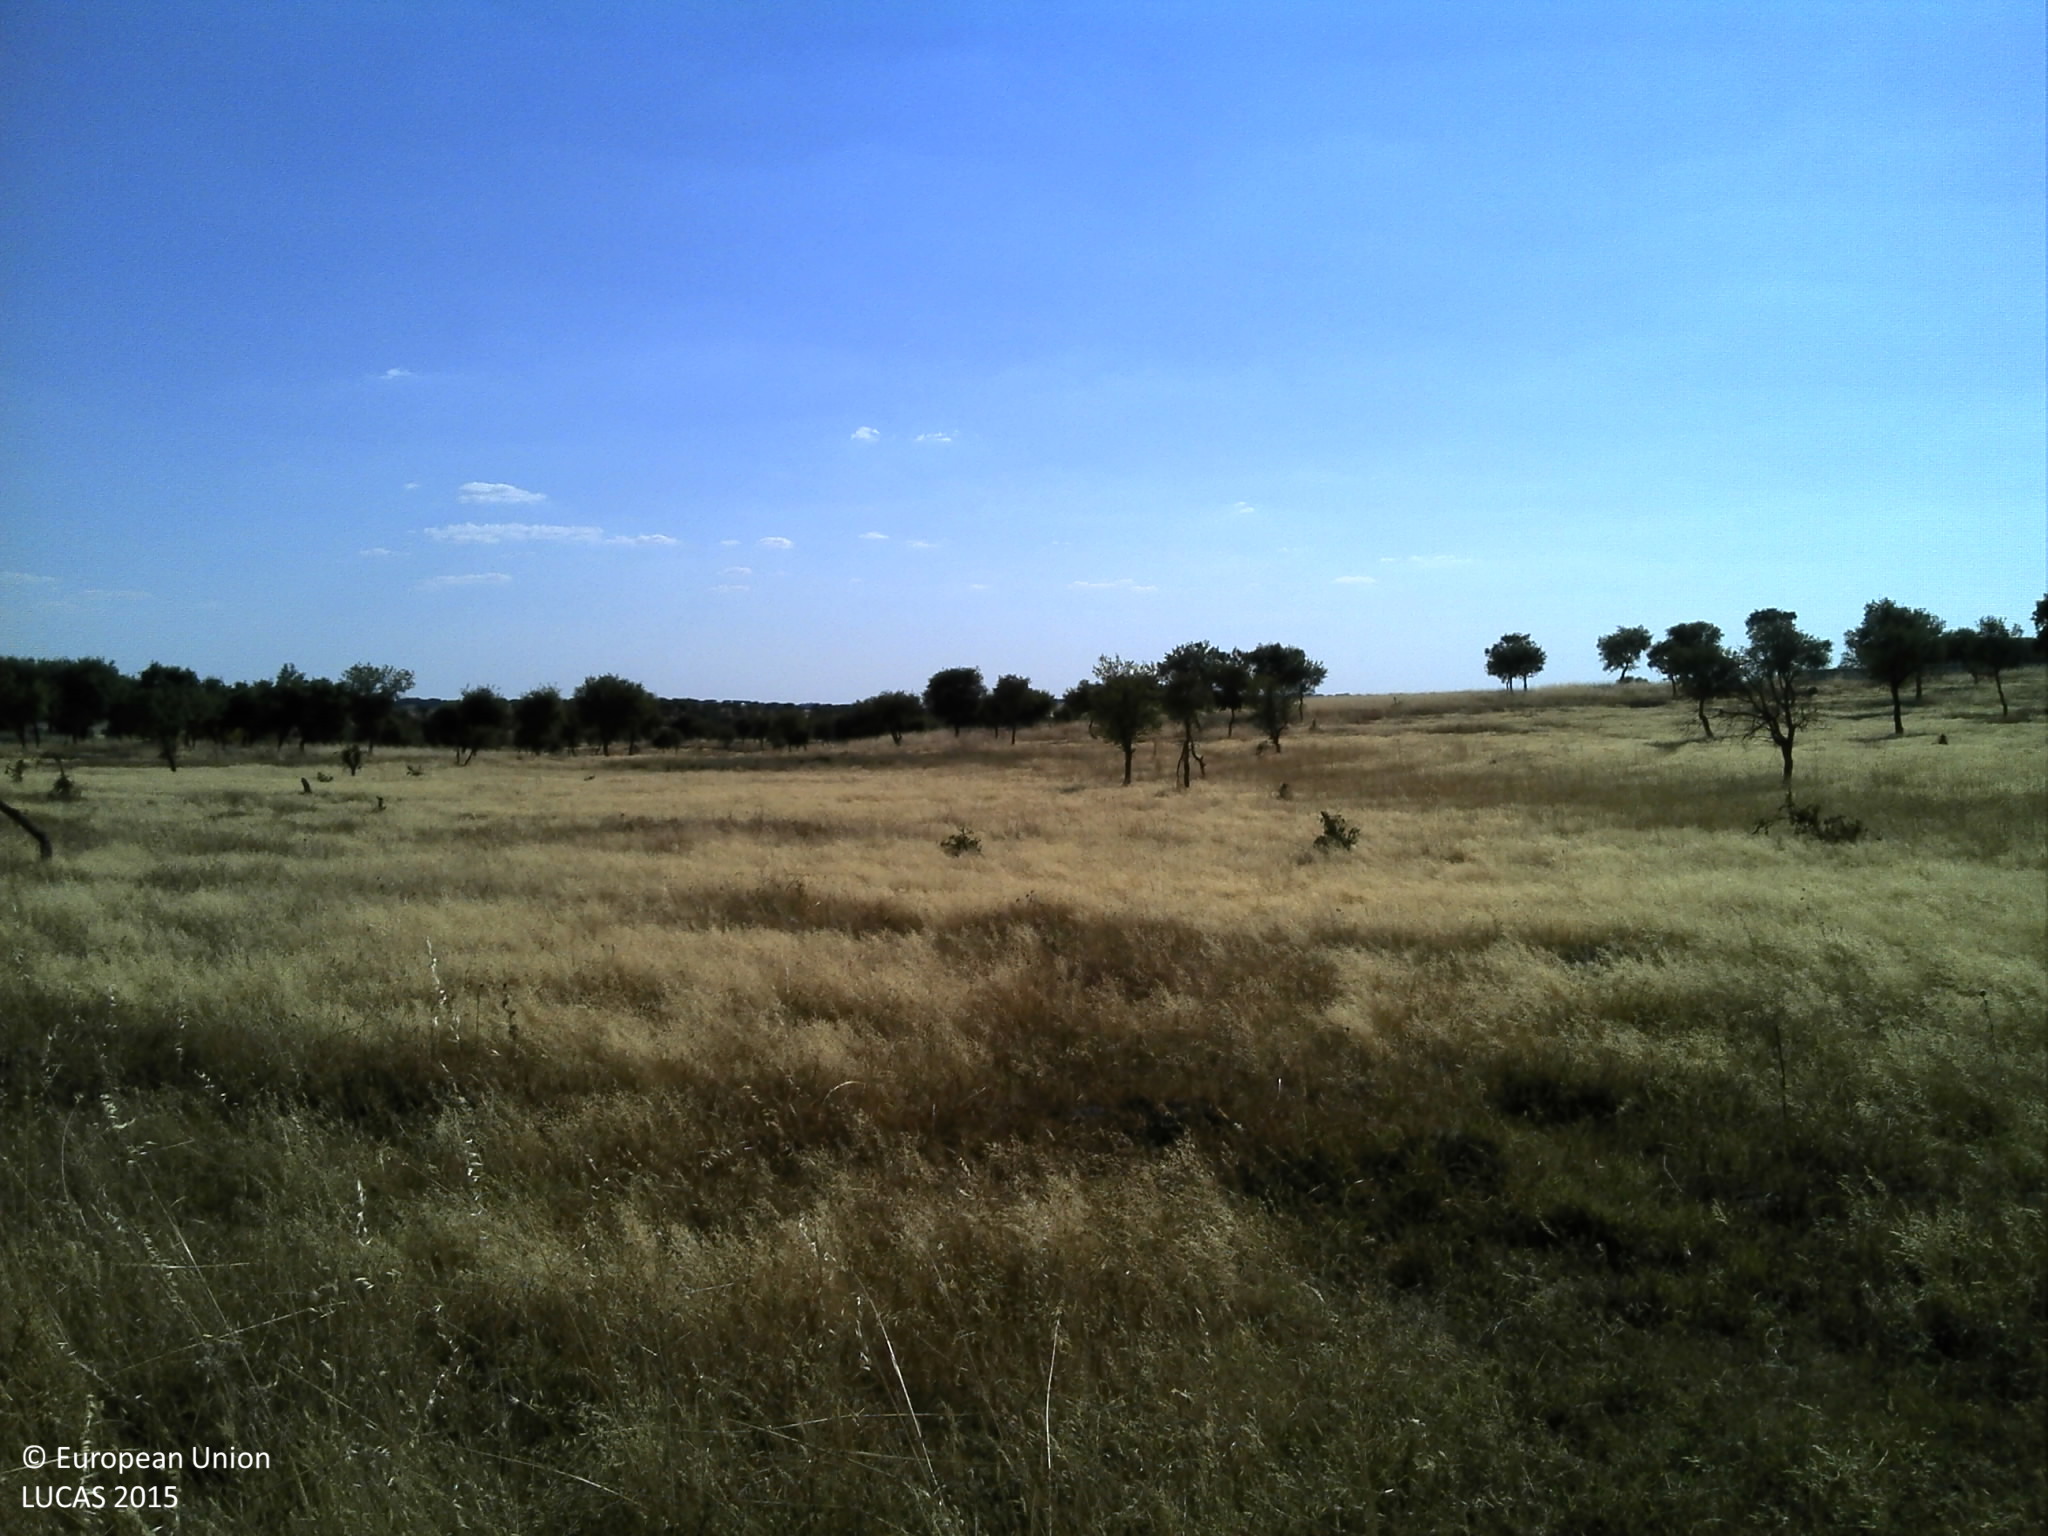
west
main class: Woodland
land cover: Broadleaved woodland
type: broadleaved evergreen forest
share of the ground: 10 - 25 %
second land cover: Grassland without tree/shrub cover
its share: 25 - 50 %
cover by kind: unconsolidated bare surface 65 %, herbaceous plants 25 %, broadleaved forest trees 10 %
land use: Forestry
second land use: Agriculture (excluding fallow land and kitchen gardens)
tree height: < 5 m
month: June
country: PT
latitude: 38.4624
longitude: -7.9746
